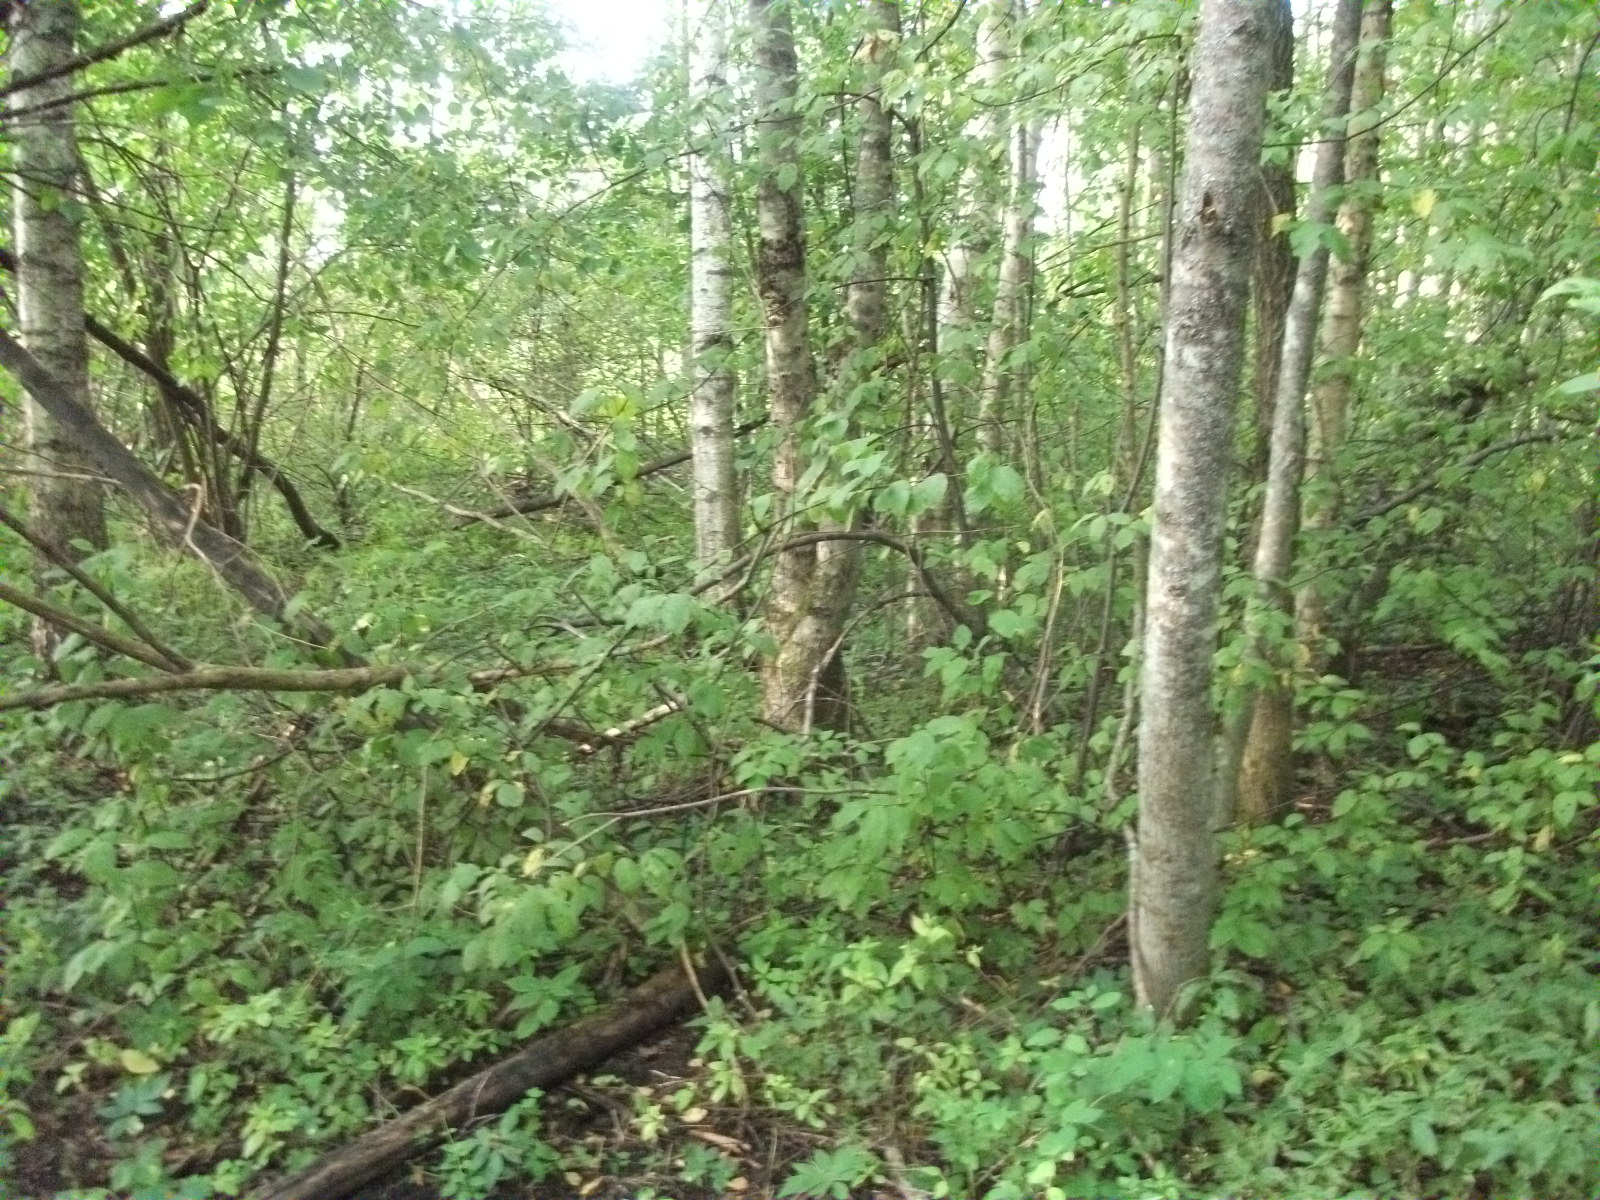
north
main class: Woodland
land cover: Broadleaved woodland
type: non-riverine alder, birch or aspen forest
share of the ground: > 75 %
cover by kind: broadleaved forest trees 75 %, herbaceous plants 10 %, coniferous forest trees 5 %, shrubs 5 %, unconsolidated bare surface 5 %
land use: Forestry
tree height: > 5 m
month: August
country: LV
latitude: 56.9004
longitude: 26.4483
